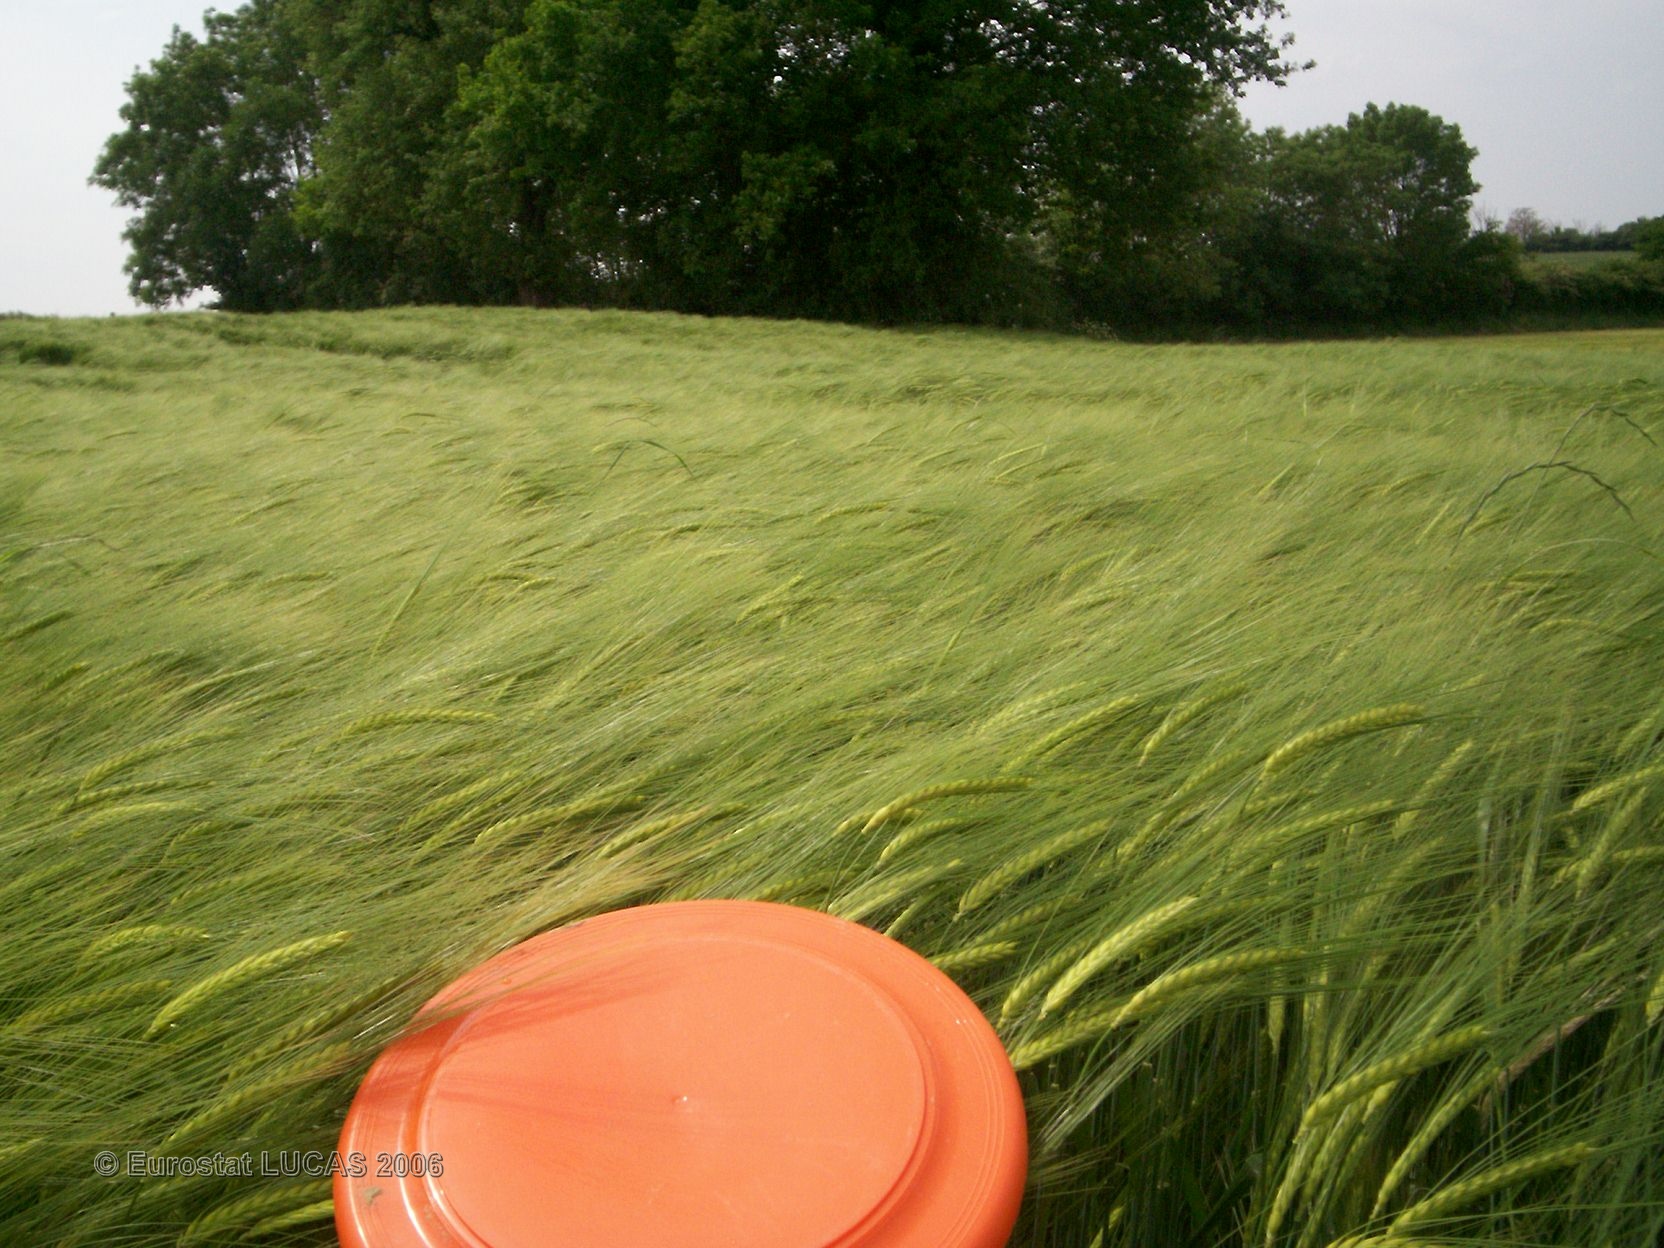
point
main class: Cropland
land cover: Barley
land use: Agriculture (excluding fallow land and kitchen gardens)
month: May
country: FR
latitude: 46.6322
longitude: -0.8593
